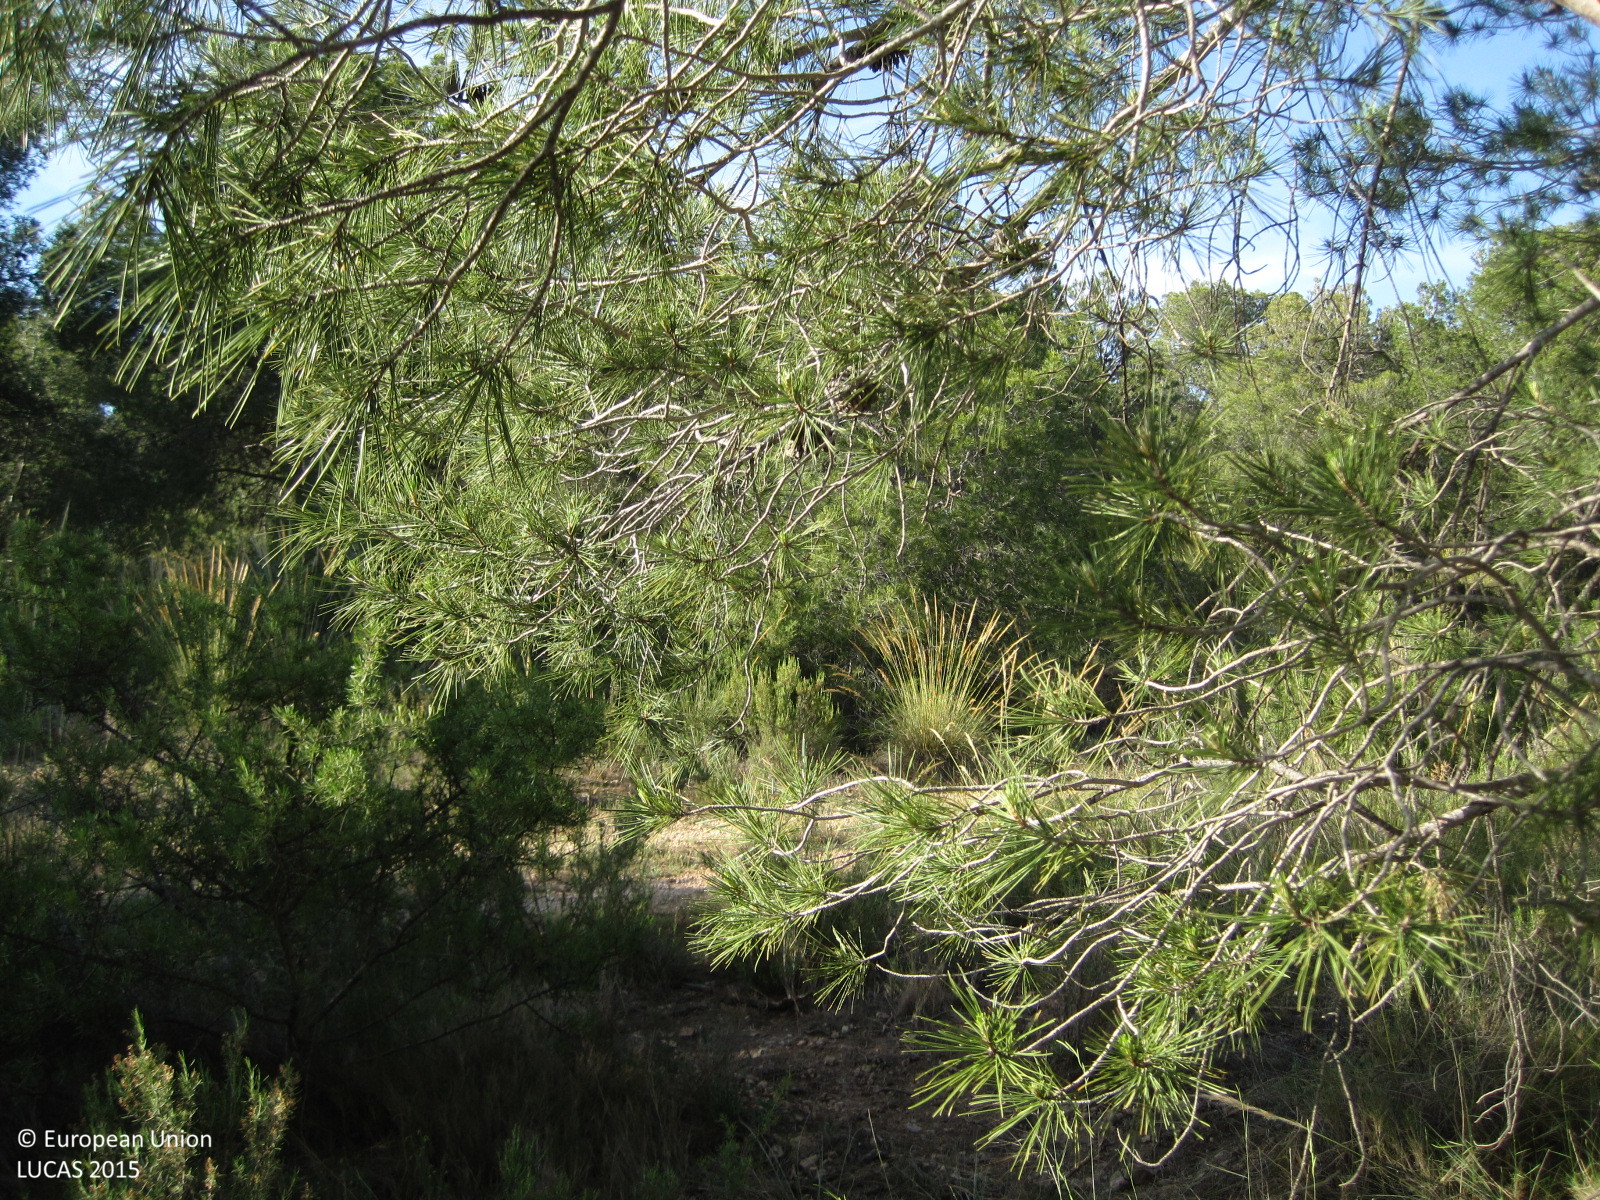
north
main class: Woodland
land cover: Pine dominated coniferous woodland
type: coniferous forest of the mediterranean region
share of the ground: > 75 %
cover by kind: shrubs 55 %, coniferous forest trees 25 %, herbaceous plants 10 %, consolidated bare surface 10 %
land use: Semi-natural and natural areas not in use
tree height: > 5 m
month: May
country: ES
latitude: 39.7221
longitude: -0.6525
